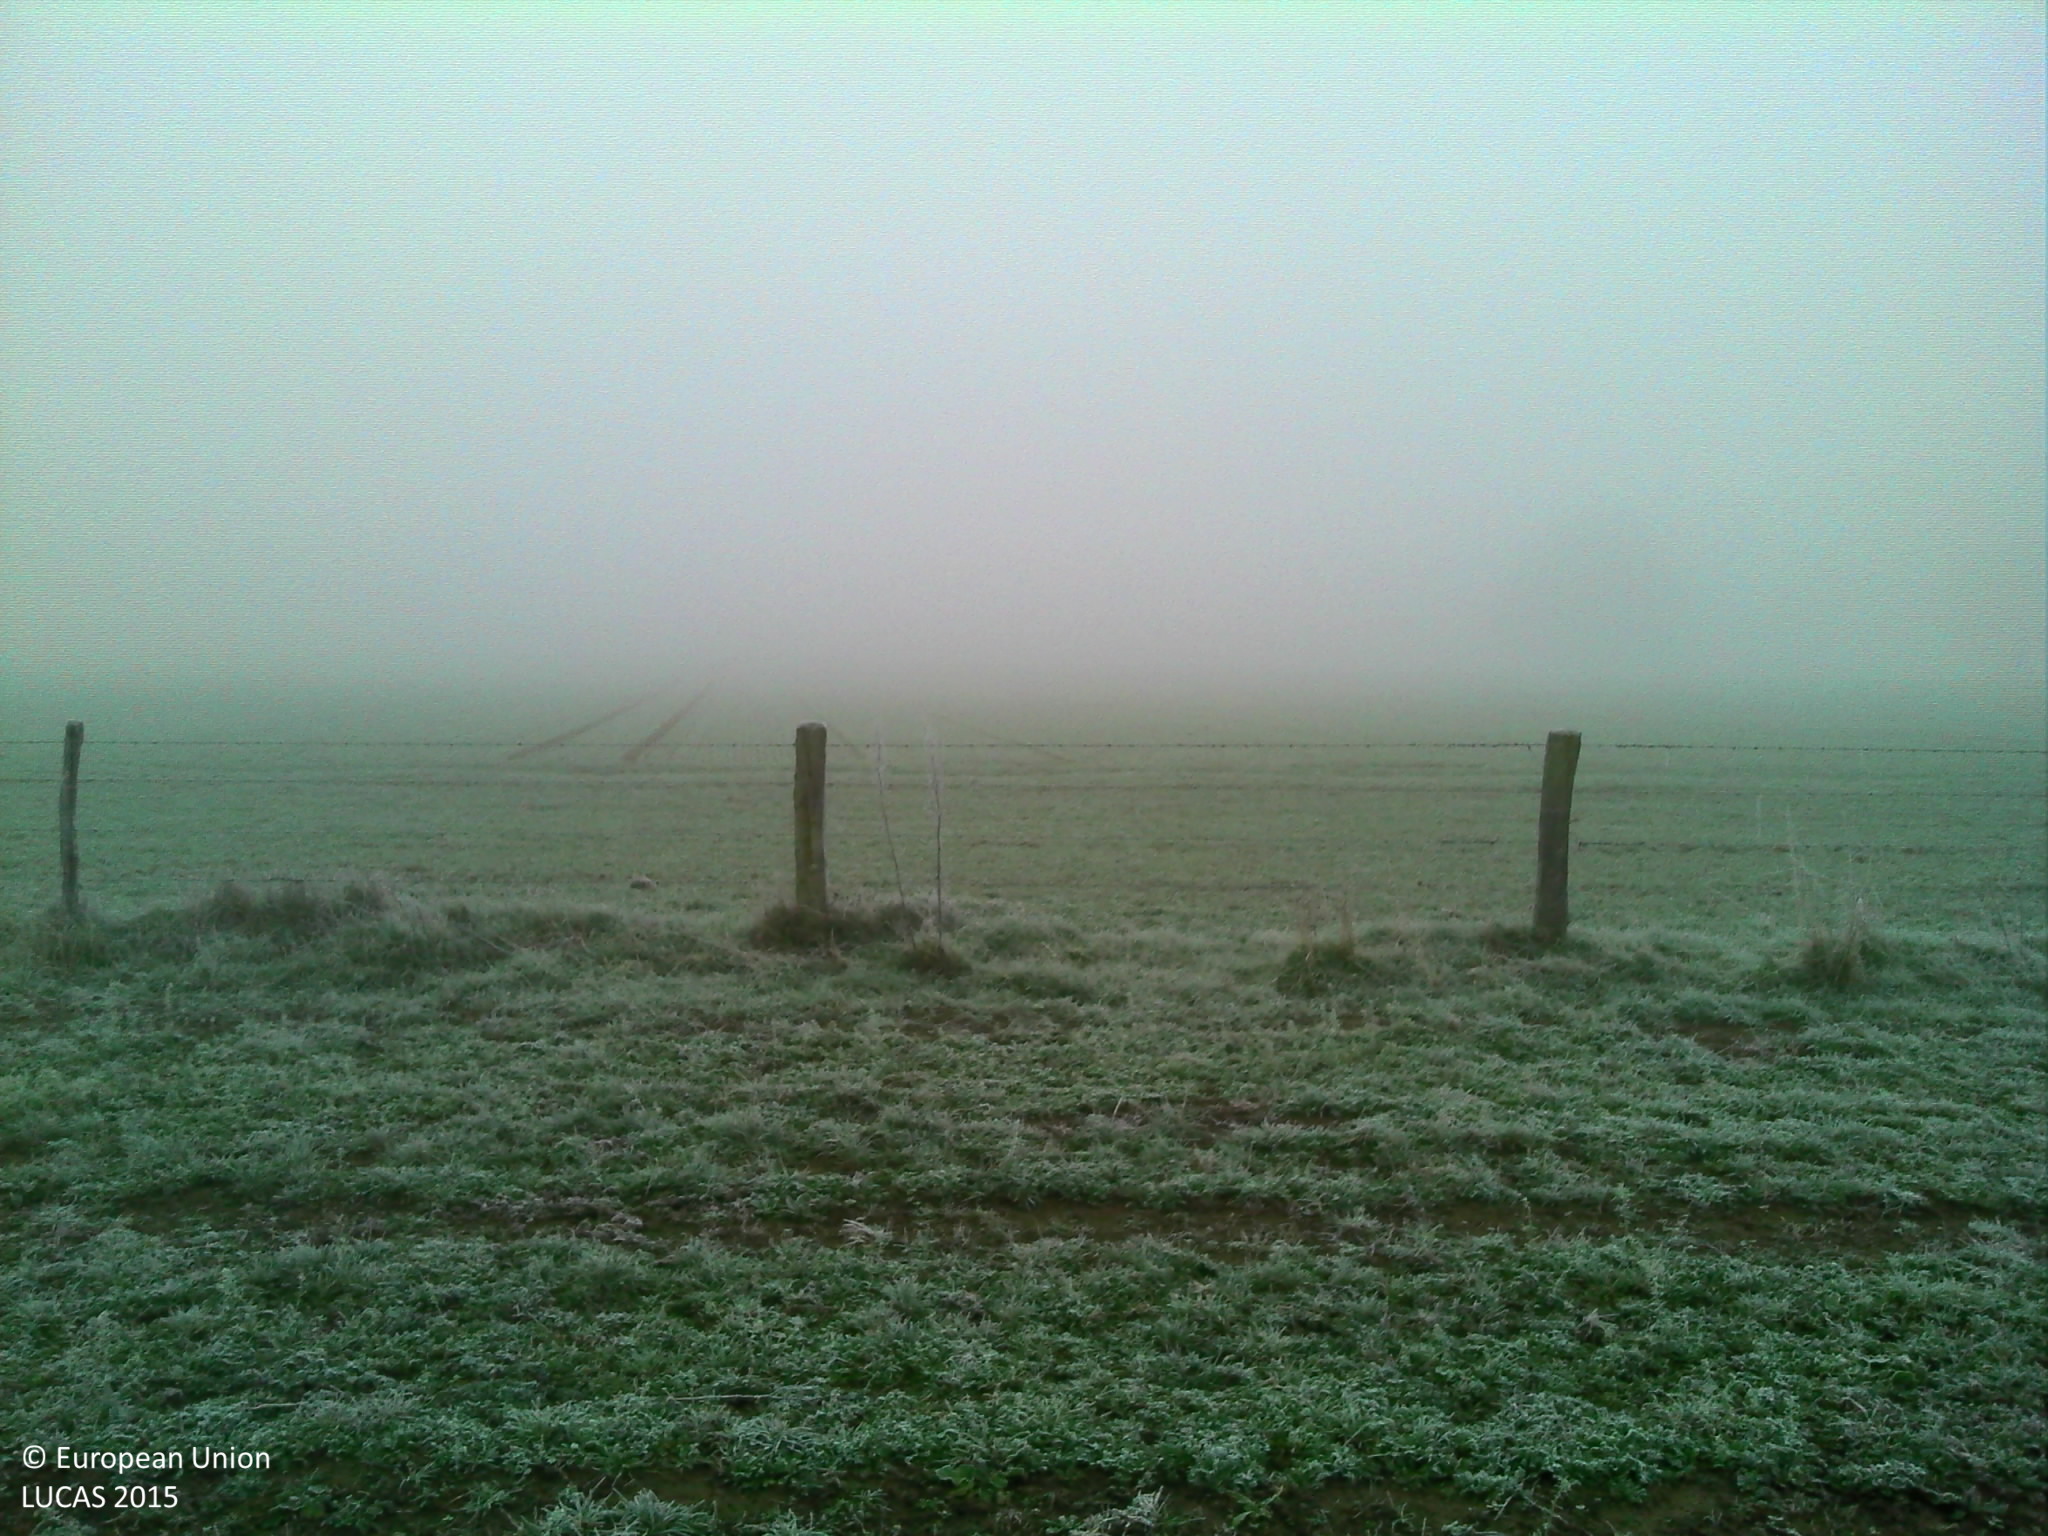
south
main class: Grassland
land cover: Grassland without tree/shrub cover
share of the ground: > 75 %
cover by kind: herbaceous plants 100 %
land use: Agriculture (excluding fallow land and kitchen gardens)
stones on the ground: < 10 %
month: November
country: FR
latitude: 46.5566
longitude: 3.5945
